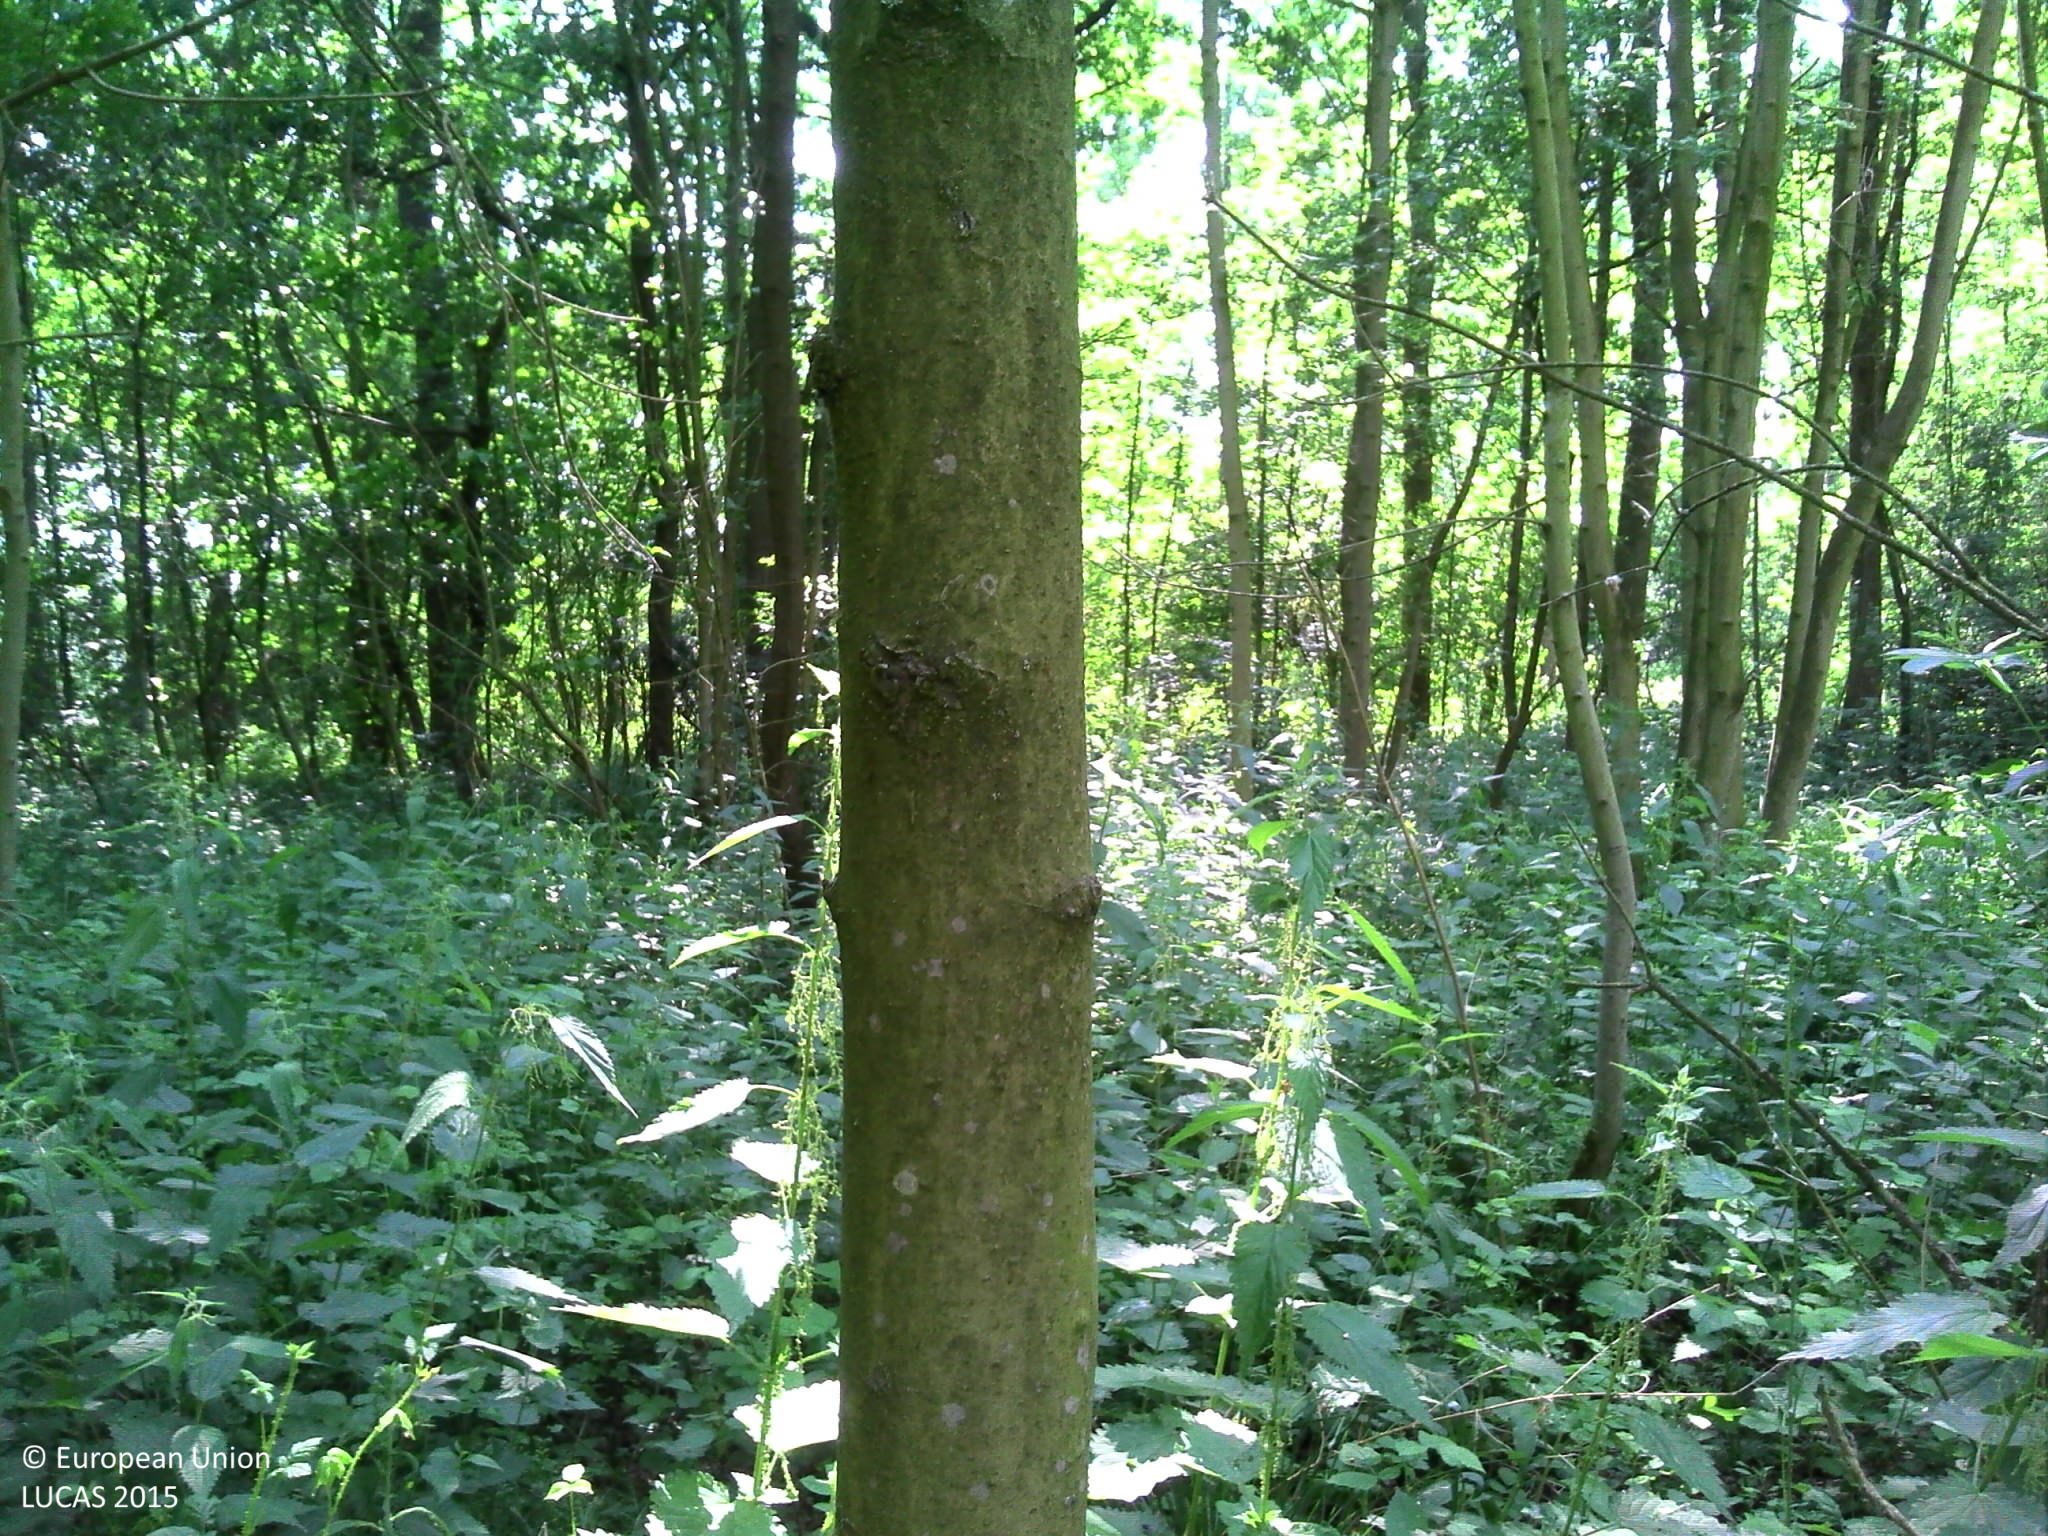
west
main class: Woodland
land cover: Broadleaved woodland
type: acidophilous oak and oak-birch forest
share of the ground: > 75 %
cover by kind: broadleaved forest trees 100 %
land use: Forestry
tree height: > 5 m
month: June
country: BE
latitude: 51.0340
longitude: 3.9619
